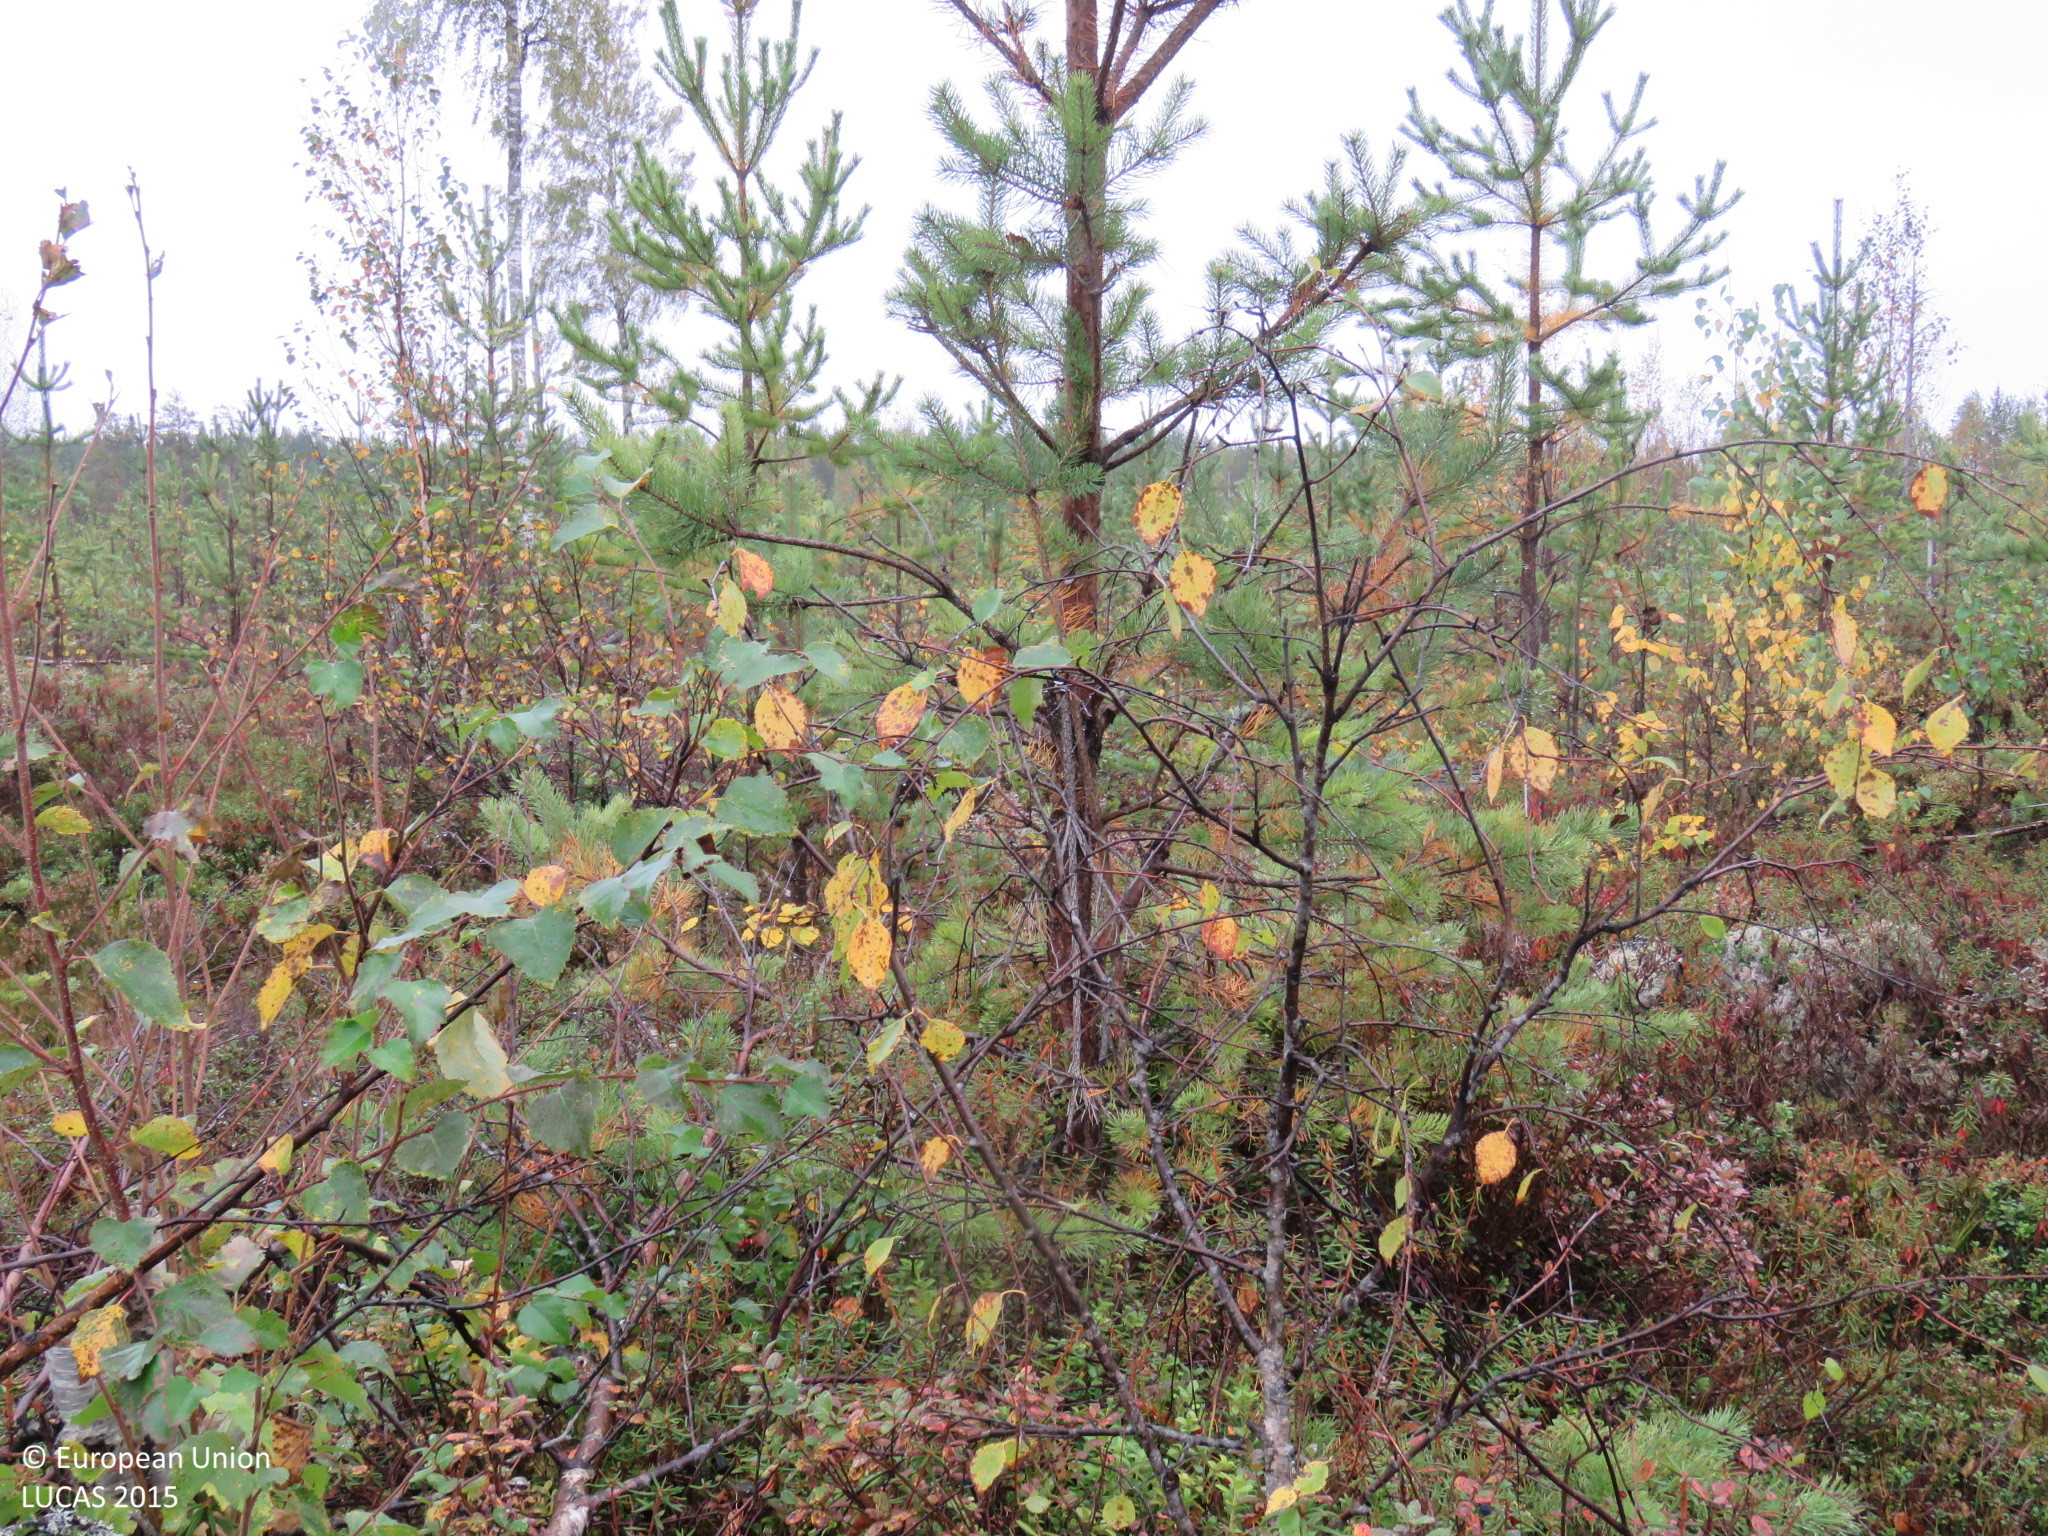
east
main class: Woodland
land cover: Pine dominated mixed woodland
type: boreal forest
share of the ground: 50 - 75 %
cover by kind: coniferous forest trees 30 %, shrubs 30 %, broadleaved forest trees 20 %, lichens and mosses 15 %, herbaceous plants 5 %
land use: Forestry
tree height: < 5 m
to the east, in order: Pine dominated mixed woodland; Other mixed woodland; Pine dominated coniferous woodland; Pine dominated mixed woodland; Pine dominated coniferous woodland; Peatbogs; Pine dominated coniferous woodland
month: September
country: FI
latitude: 64.8346
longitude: 26.5729
